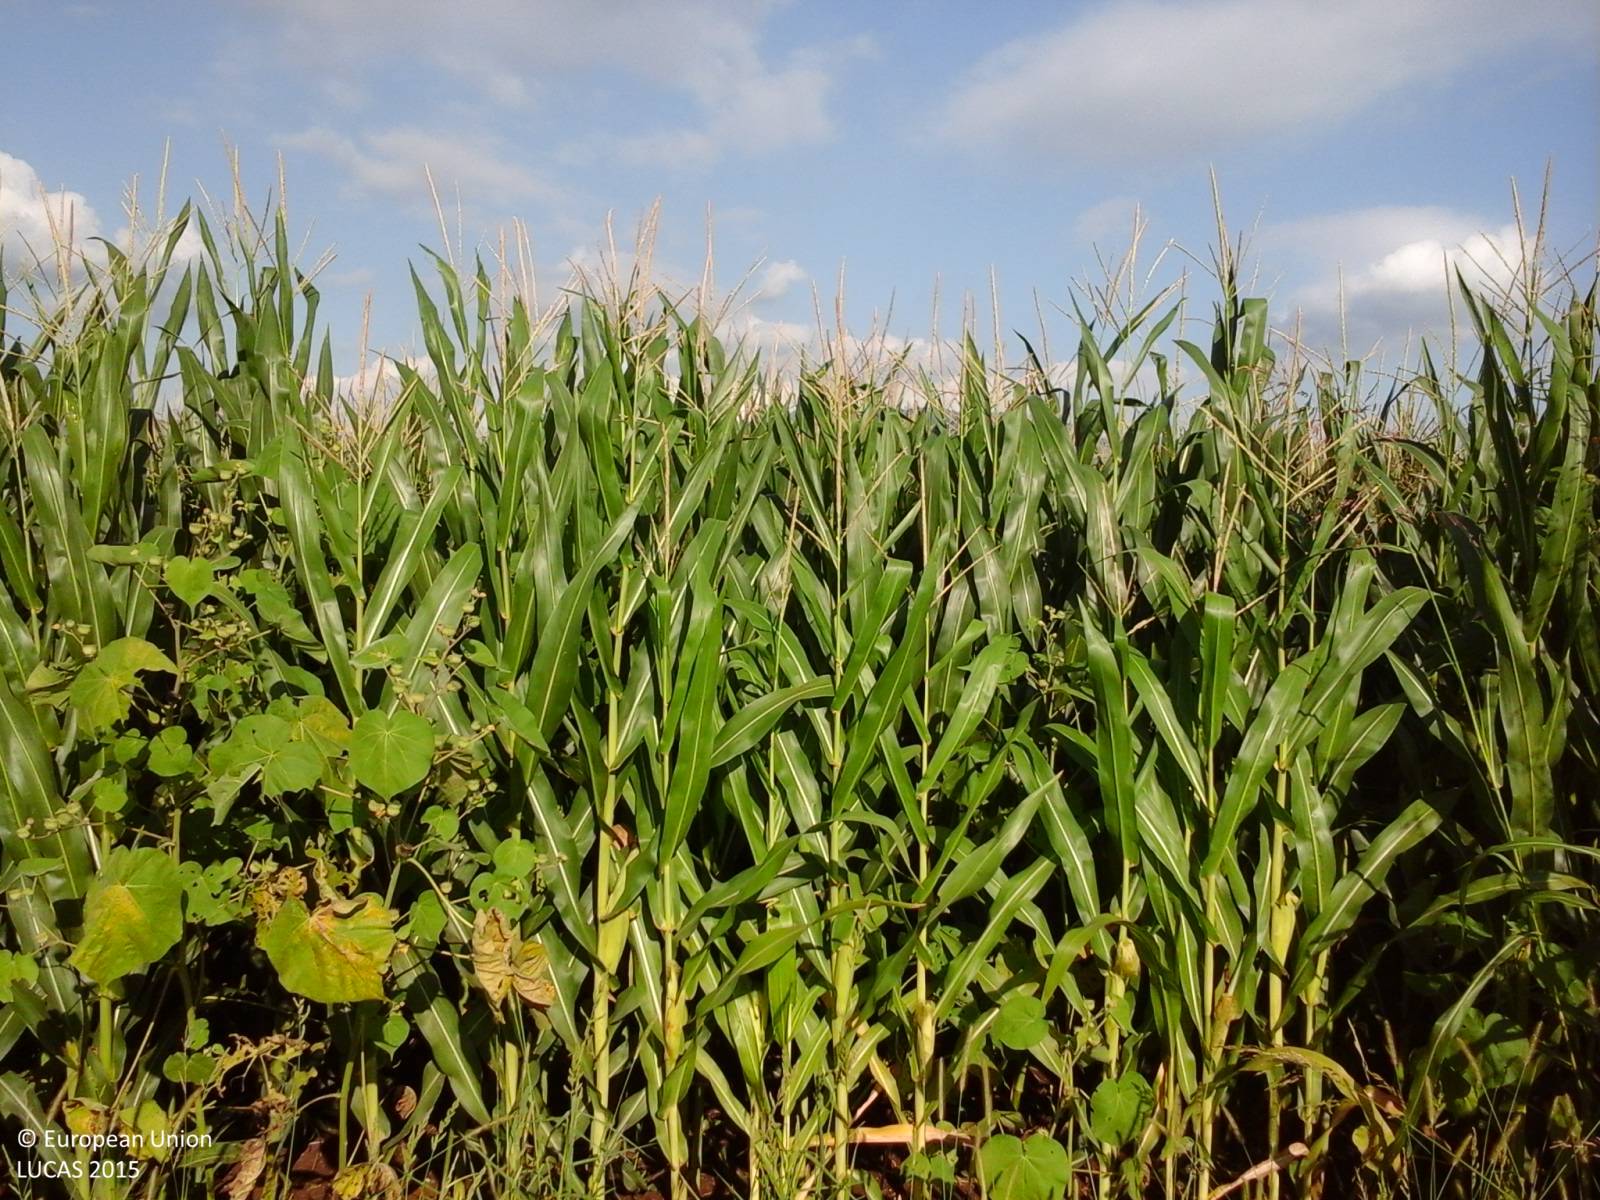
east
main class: Cropland
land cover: Maize
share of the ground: > 75 %
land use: Agriculture (excluding fallow land and kitchen gardens)
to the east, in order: Maize; Electric lines; Maize; Shruby margins; Ditches and canals; Grass margins; Paved roads, cycling and walking lanes; Grass margins; Ditches and canals; Shruby margins; Temporary grasslands; Electric lines; Temporary grasslands; Abandoned hedges; Ditches and canals; Grassland without tree/shrub cover
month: August
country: IT
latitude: 41.4113
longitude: 13.1576
